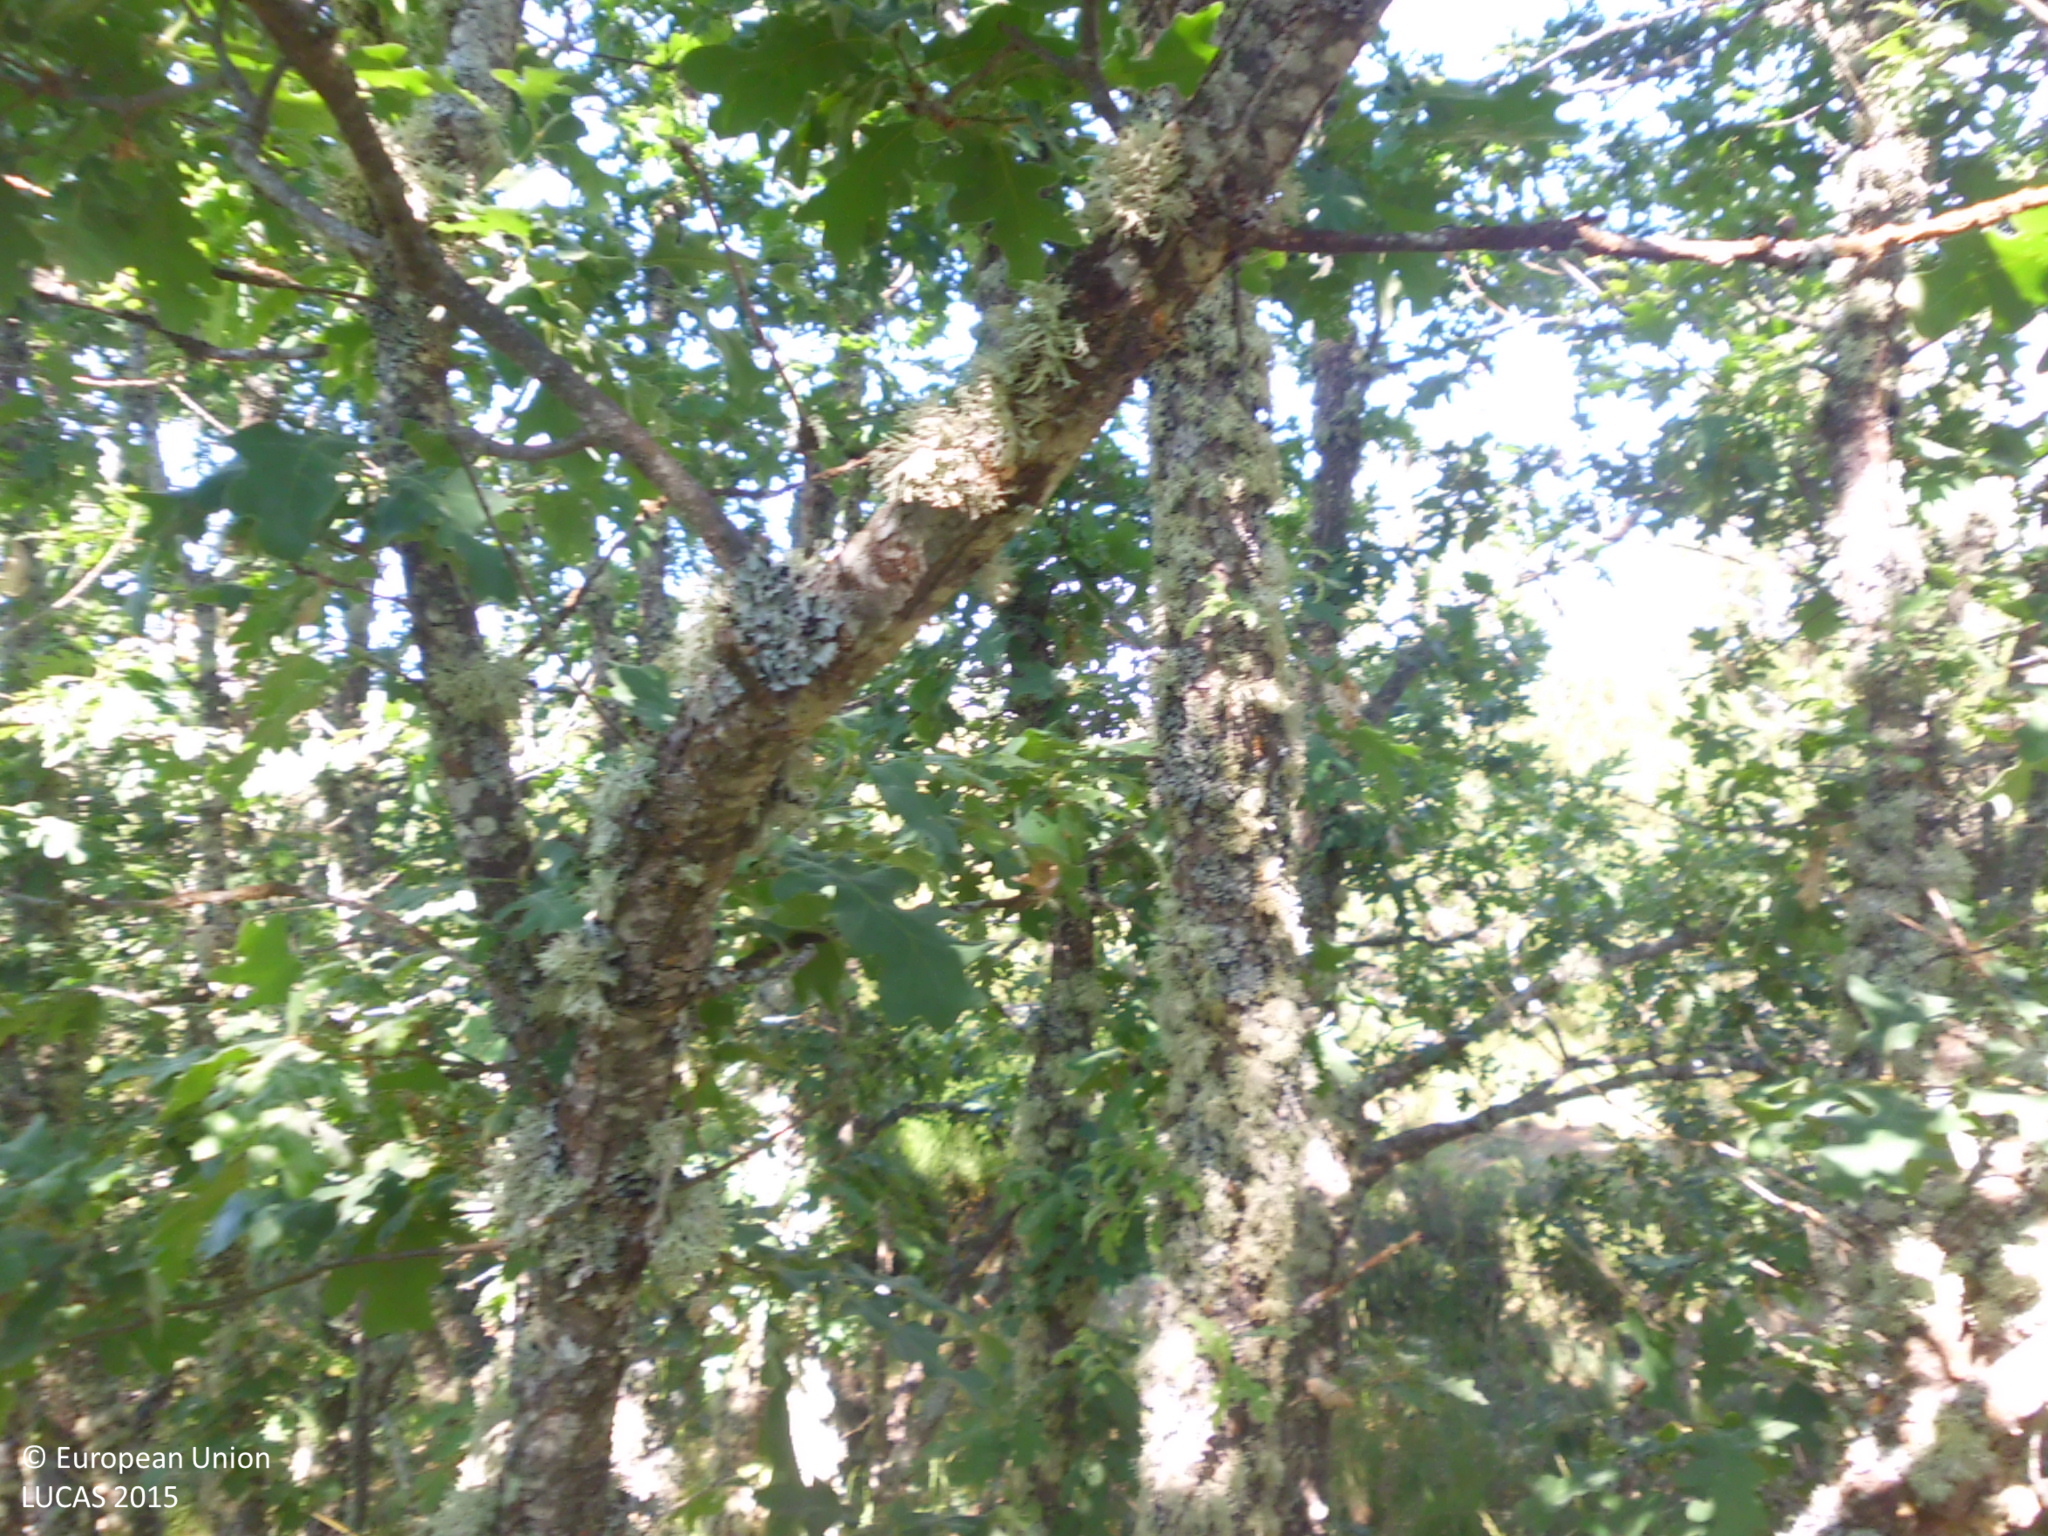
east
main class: Woodland
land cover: Broadleaved woodland
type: acidophilous oak and oak-birch forest
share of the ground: > 75 %
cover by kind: broadleaved forest trees 80 %, herbaceous plants 15 %, shrubs 5 %
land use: Forestry
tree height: > 5 m
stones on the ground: < 10 %
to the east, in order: Broadleaved woodland; Shrubland without tree cover; Broadleaved woodland; Shrubland without tree cover; Broadleaved woodland; Shrubland without tree cover
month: June
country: ES
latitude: 42.8062
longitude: -4.4213
